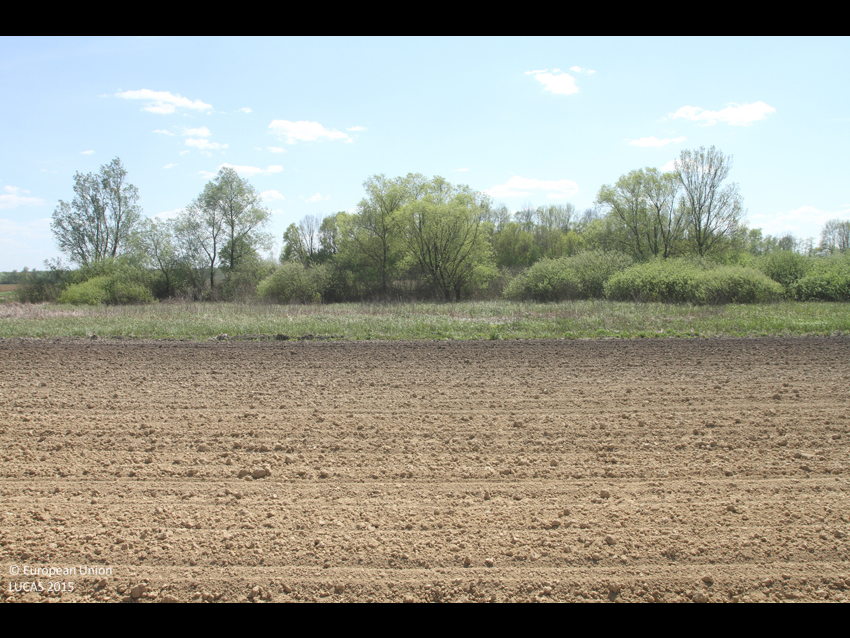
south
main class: Cropland
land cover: Soya
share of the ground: < 10 %
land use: Agriculture (excluding fallow land and kitchen gardens)
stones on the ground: < 10 %
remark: Tilled/Sowed
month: April
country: HR
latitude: 44.8738
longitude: 18.9045
